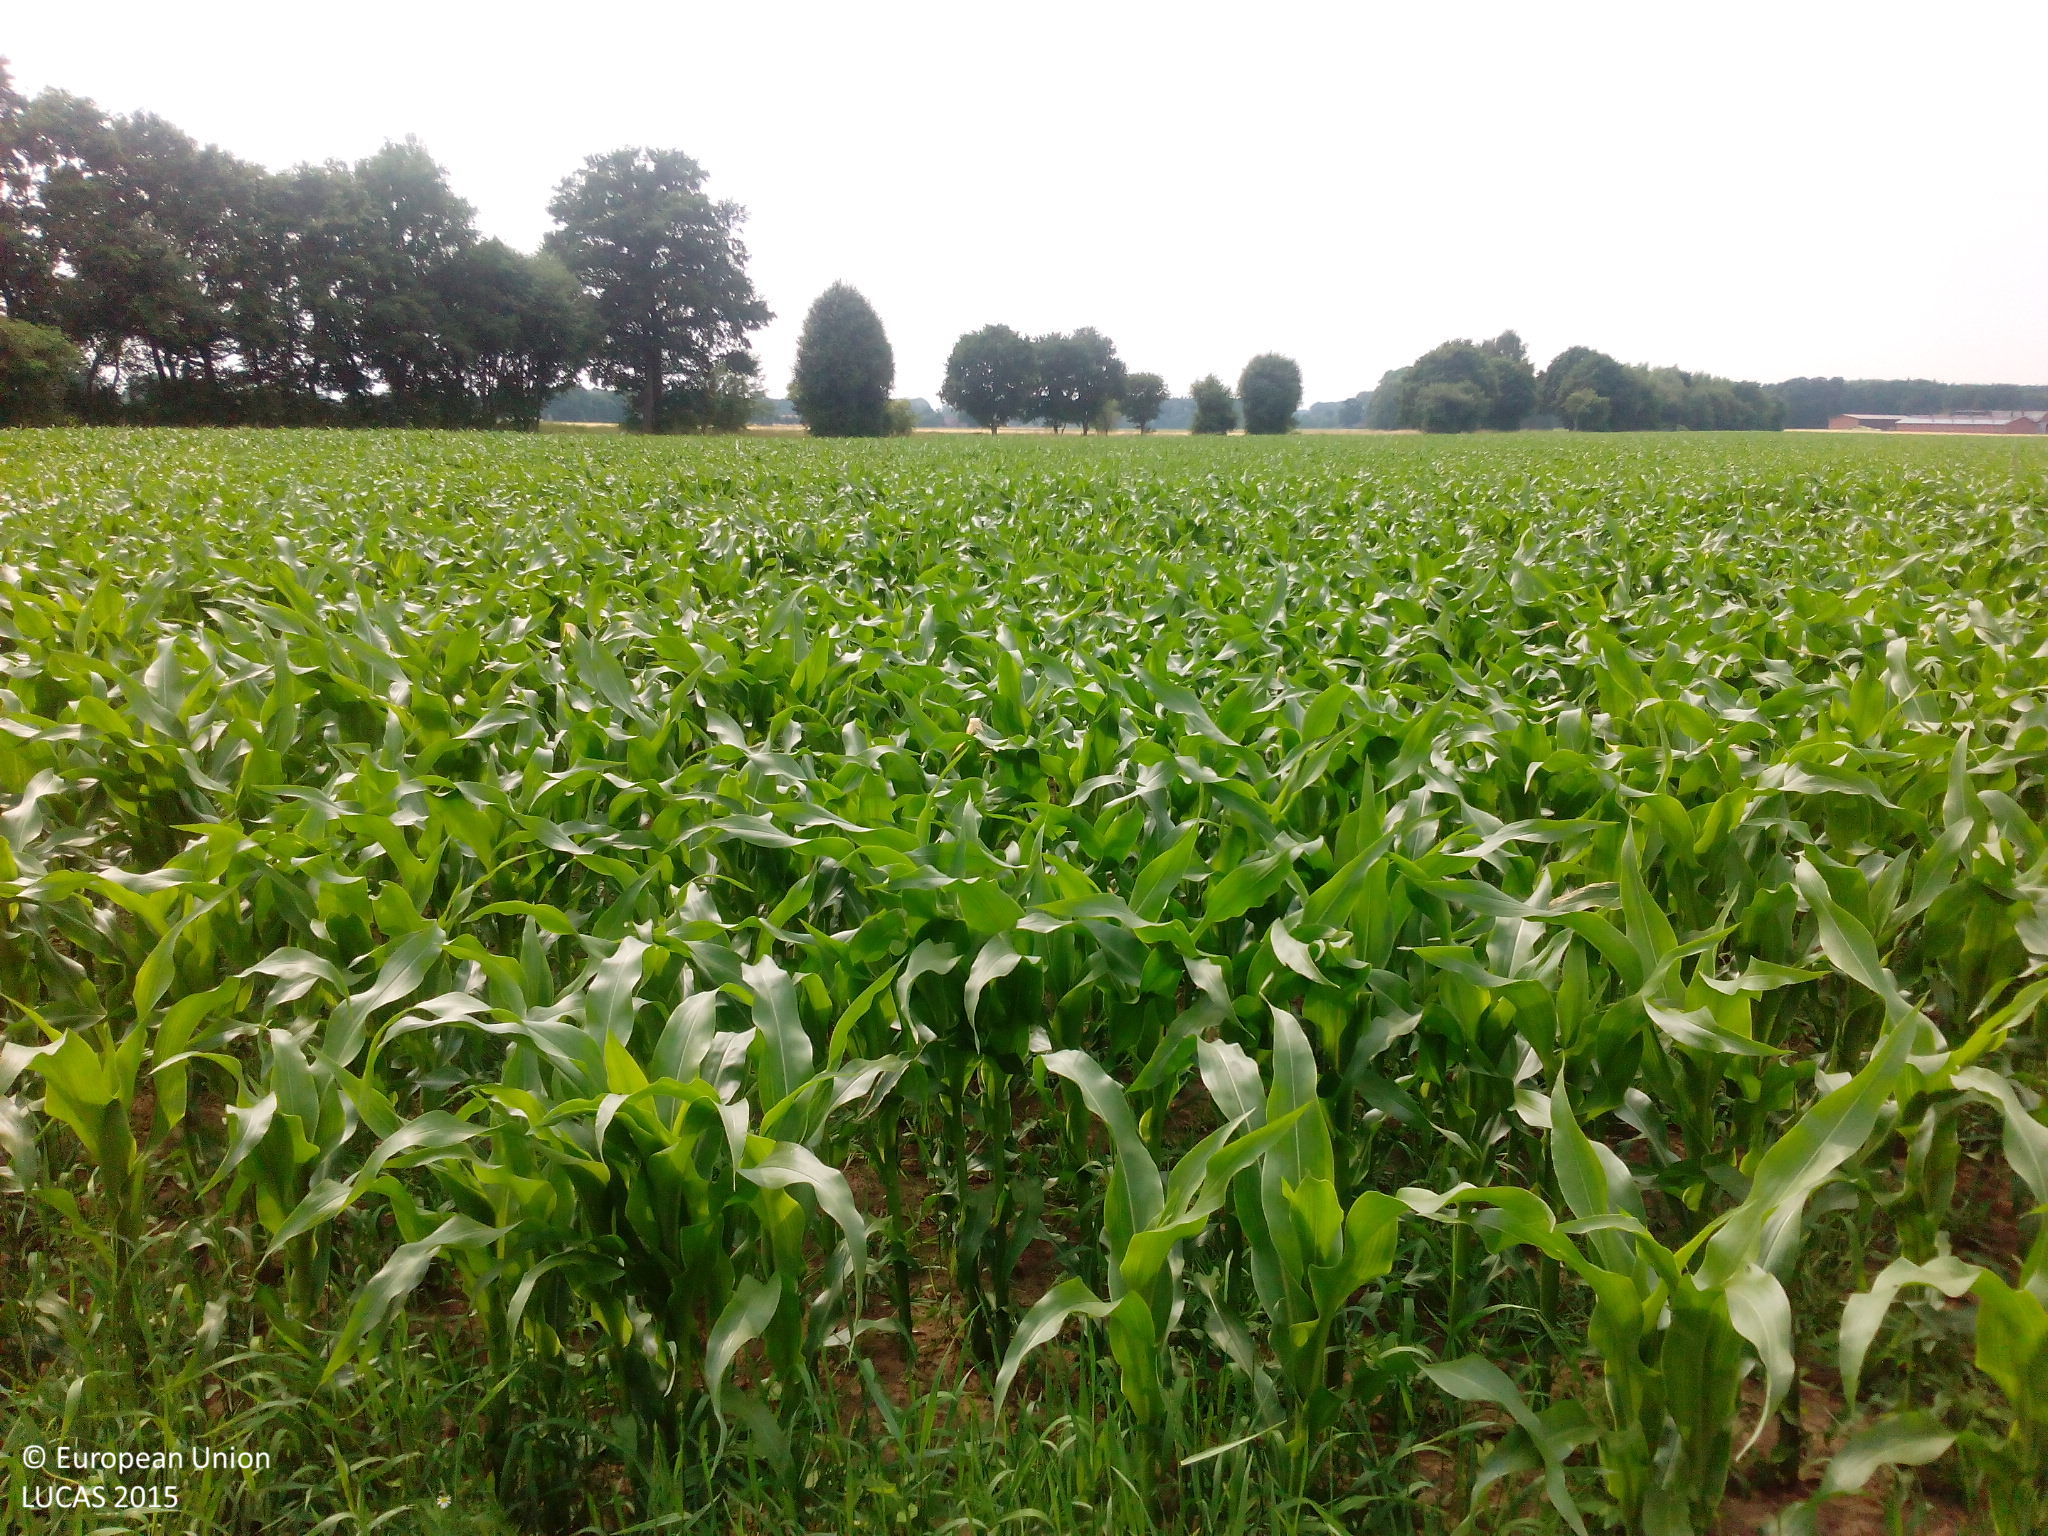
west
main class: Cropland
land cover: Maize
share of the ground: > 75 %
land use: Agriculture (excluding fallow land and kitchen gardens)
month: June
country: DE
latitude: 51.7741
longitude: 8.4497
